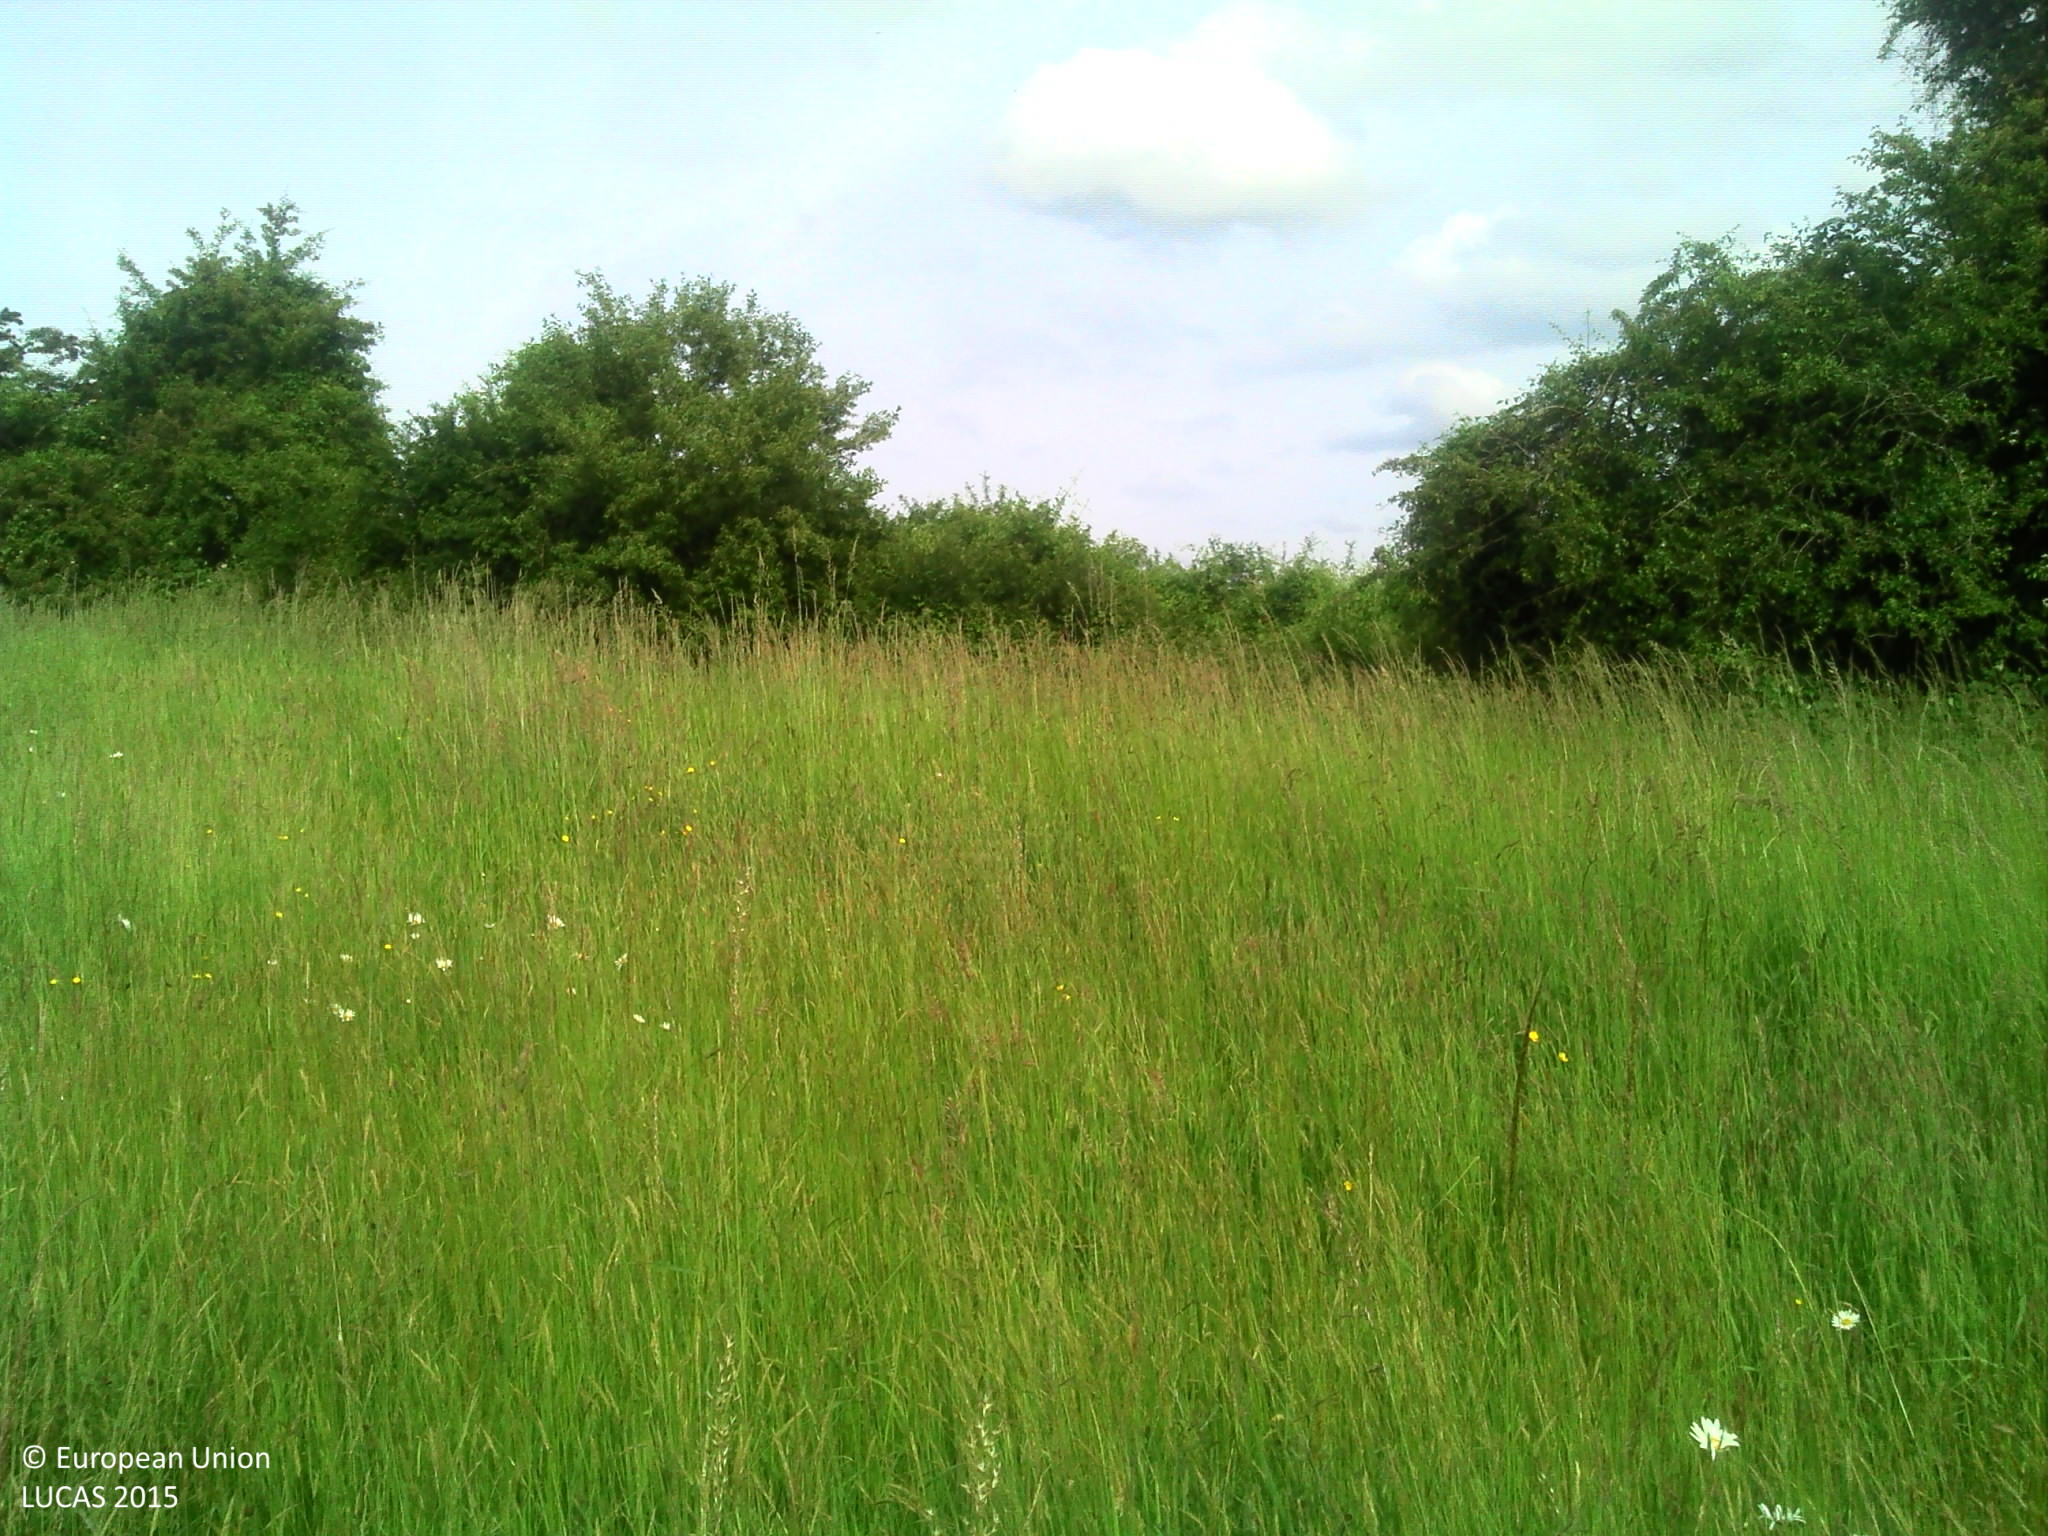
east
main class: Grassland
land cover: Spontaneously vegetated surfaces
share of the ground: > 75 %
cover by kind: herbaceous plants 95 %
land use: Semi-natural and natural areas not in use
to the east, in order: Spontaneously vegetated surfaces; Abandoned hedges; Fences; Spontaneously vegetated surfaces; Electric lines; Grassland without tree/shrub cover
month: May
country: FR
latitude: 48.7321
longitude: -0.1608
